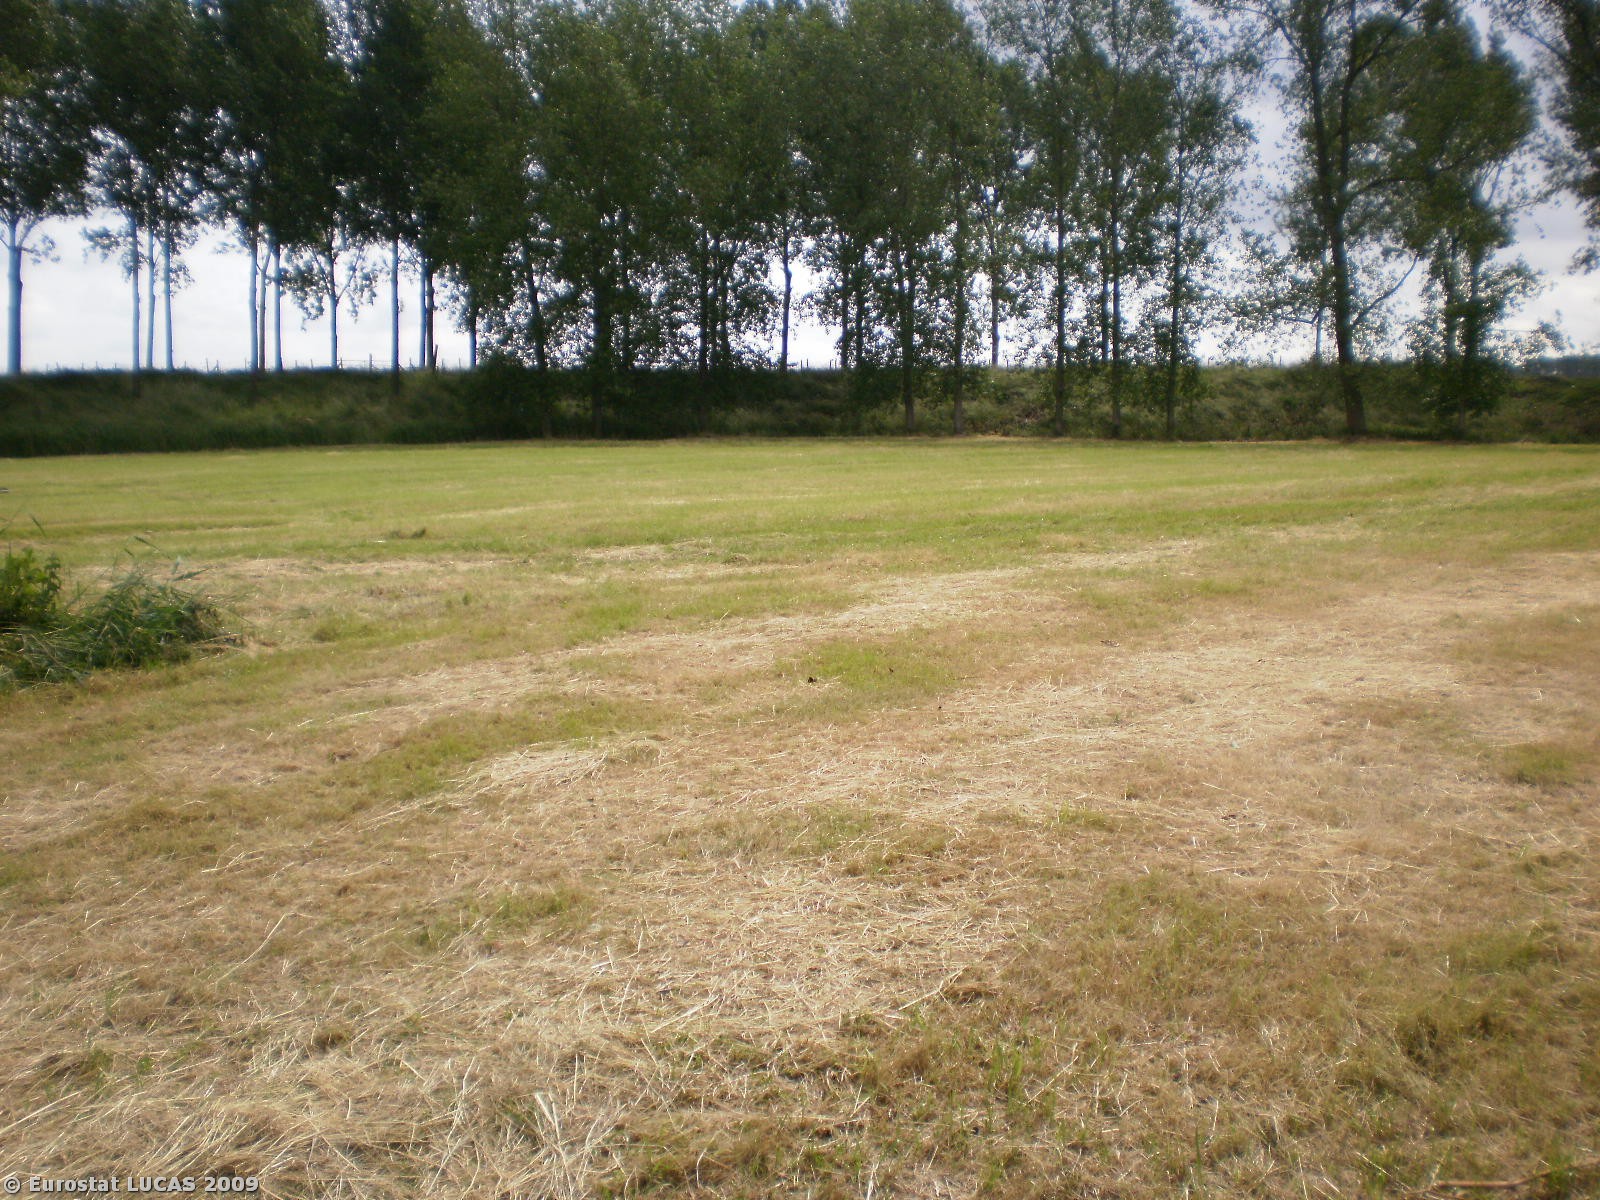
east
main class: Grassland
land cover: Grassland without tree/shrub cover
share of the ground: > 75 %
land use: Agriculture (excluding fallow land and kitchen gardens)
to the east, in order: Grassland without tree/shrub cover; Fences; Broadleaved woodland; Lines of trees; Fences; Tracks; Fences; Lines of trees; Broadleaved woodland; Arable land (only in case pi)
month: June
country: BE
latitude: 51.2799
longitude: 4.1885
